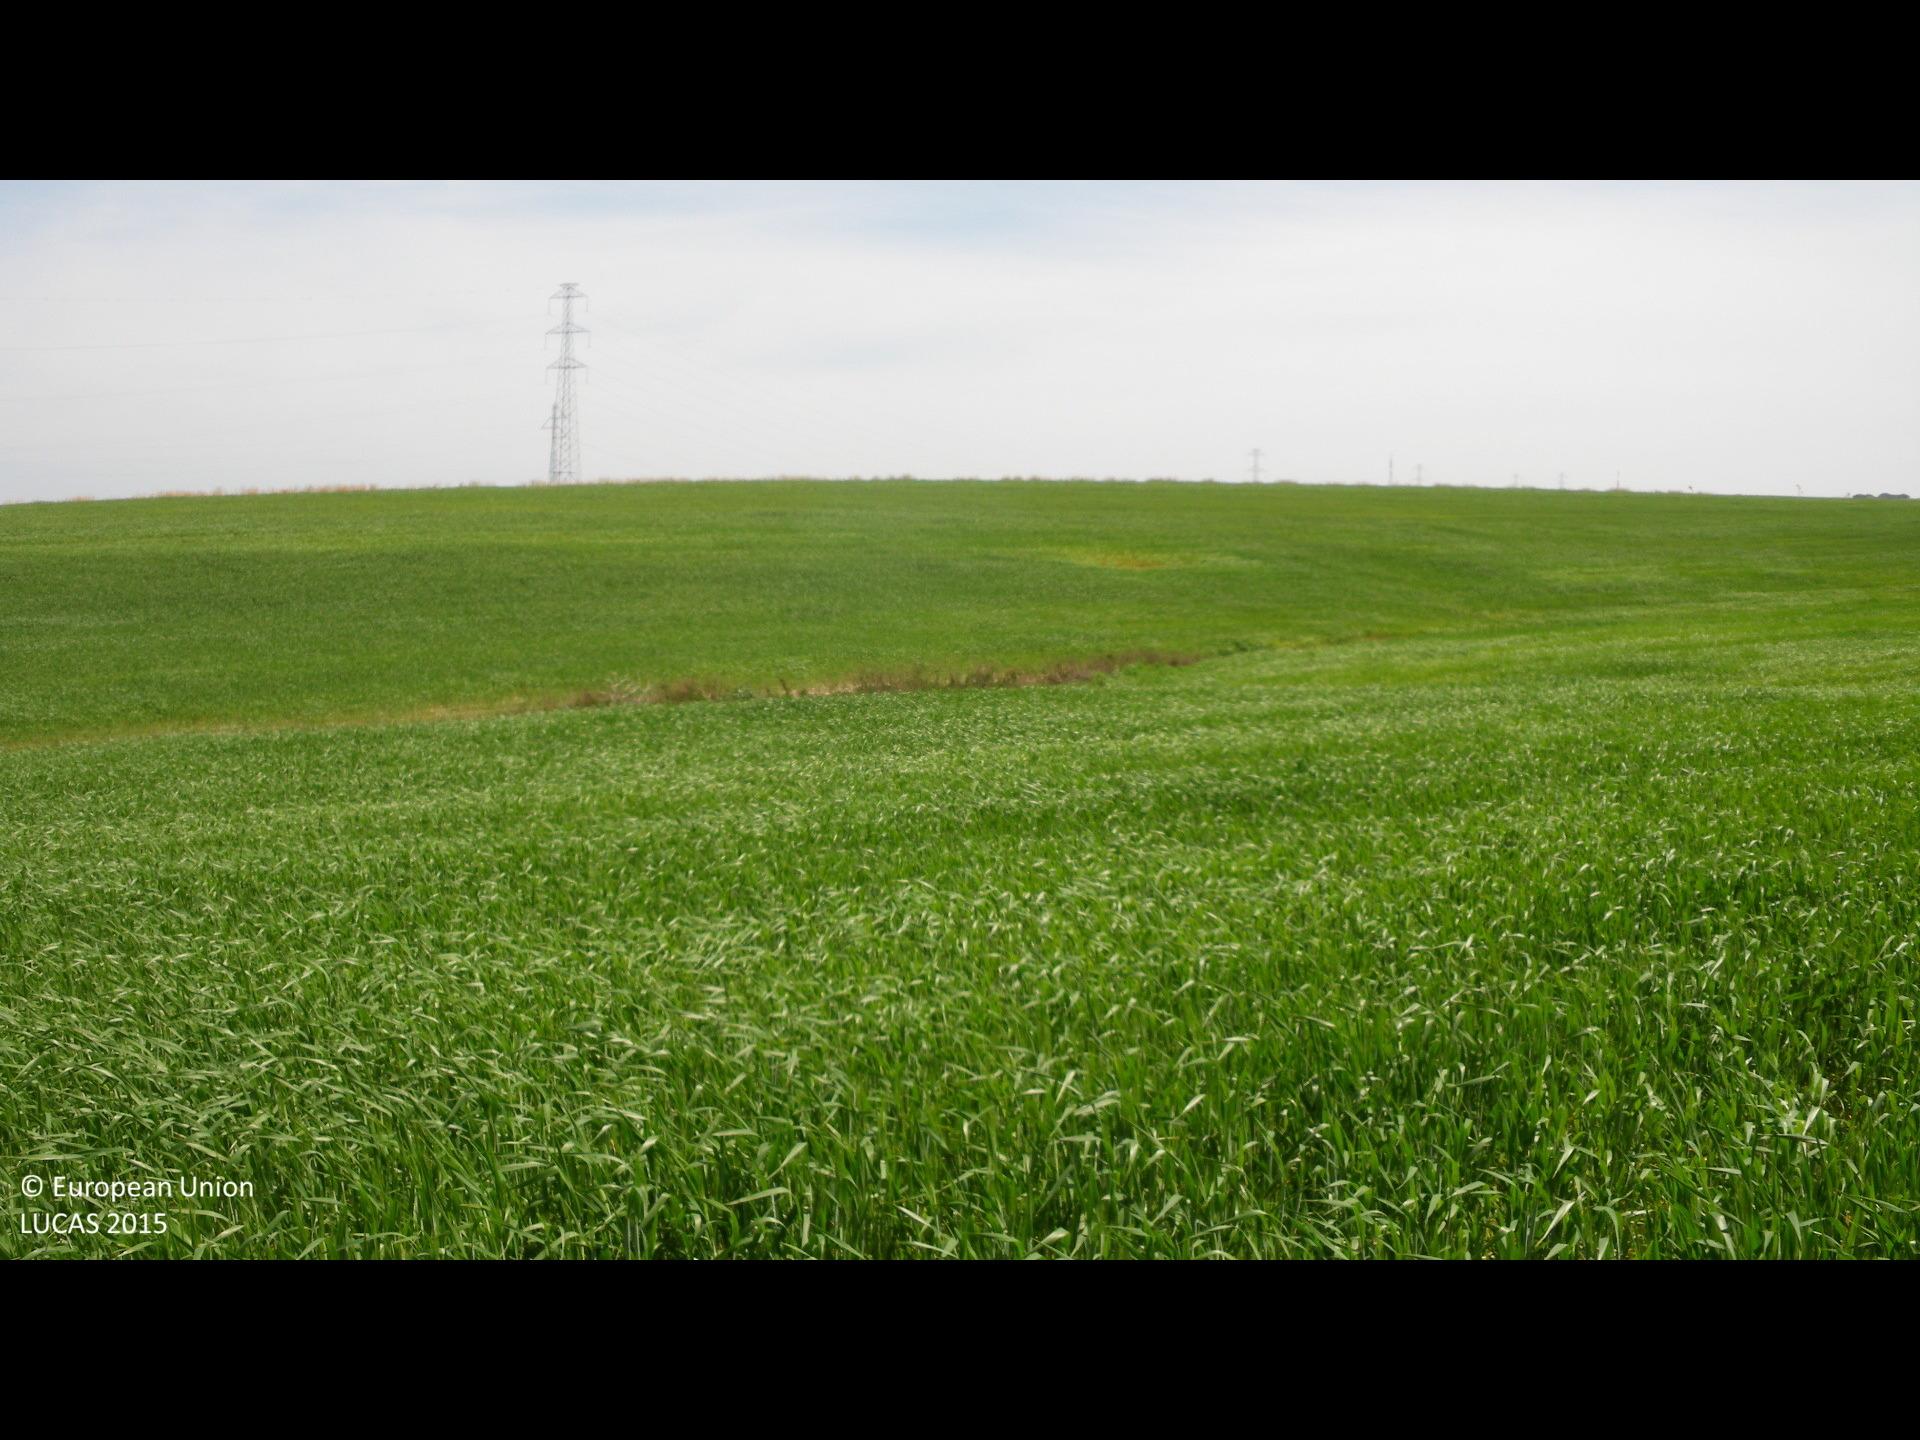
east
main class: Cropland
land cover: Common wheat
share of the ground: > 75 %
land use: Agriculture (excluding fallow land and kitchen gardens)
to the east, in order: Common wheat; Grass margins; Other structural elements; Grass margins; Common wheat; Grass margins; Tracks; Grass margins; Common wheat
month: April
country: ES
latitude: 36.6442
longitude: -6.1972
